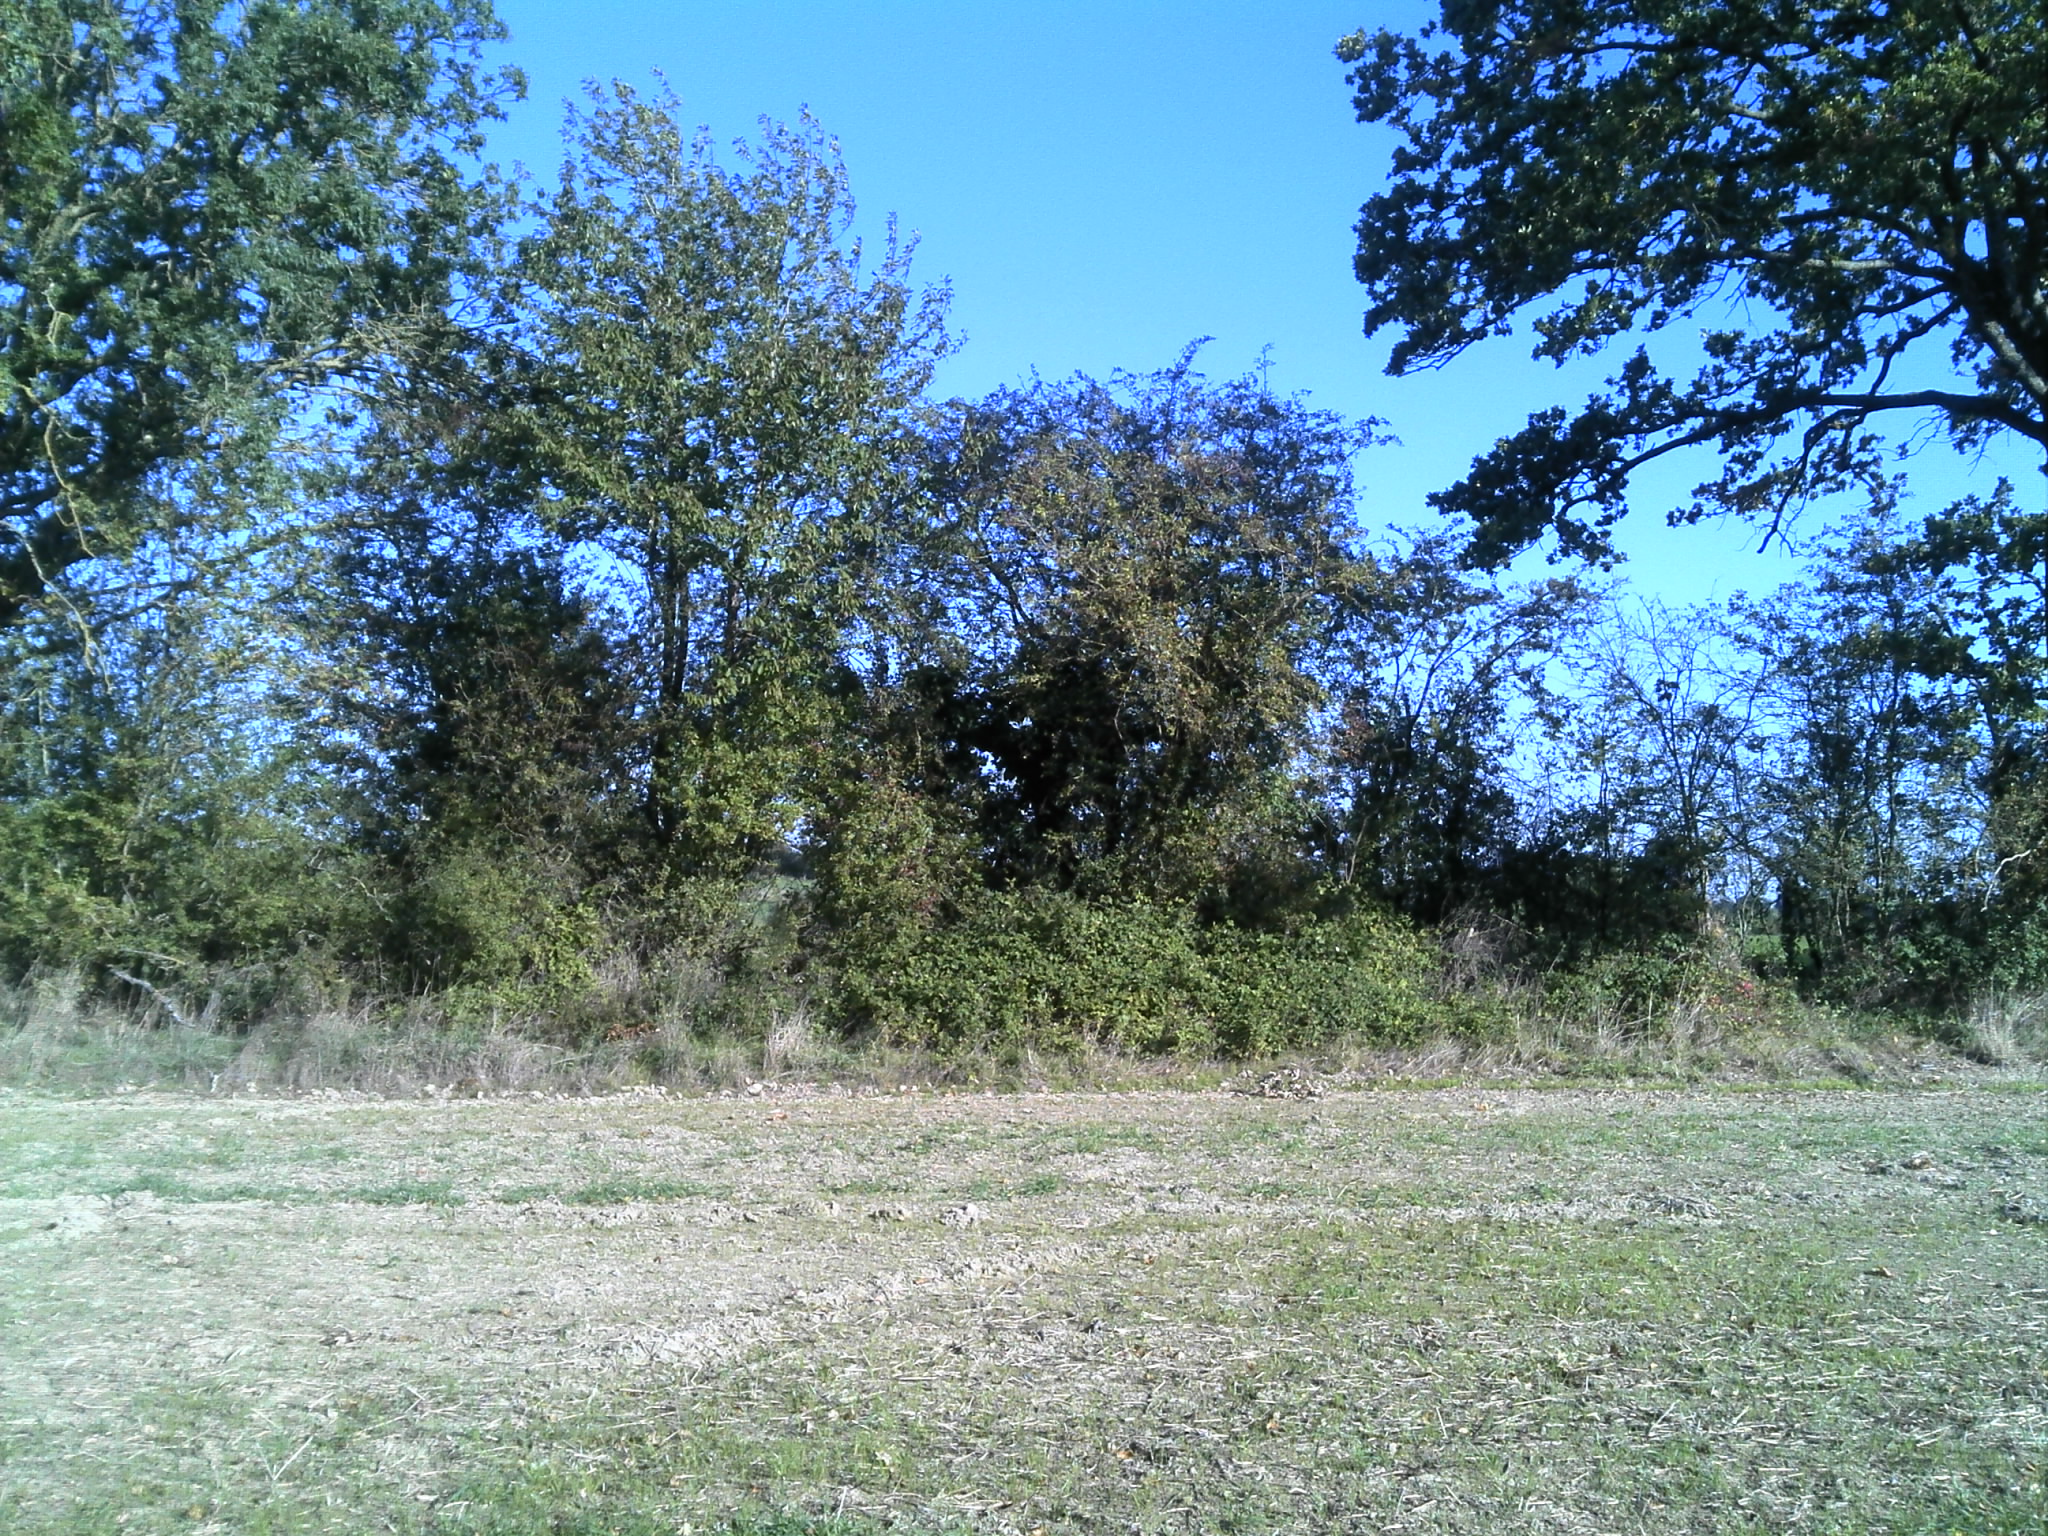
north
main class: Cropland
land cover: Temporary grasslands
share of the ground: > 75 %
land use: Agriculture (excluding fallow land and kitchen gardens)
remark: Harvested field
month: October
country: FR
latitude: 47.6279
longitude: -1.0699
